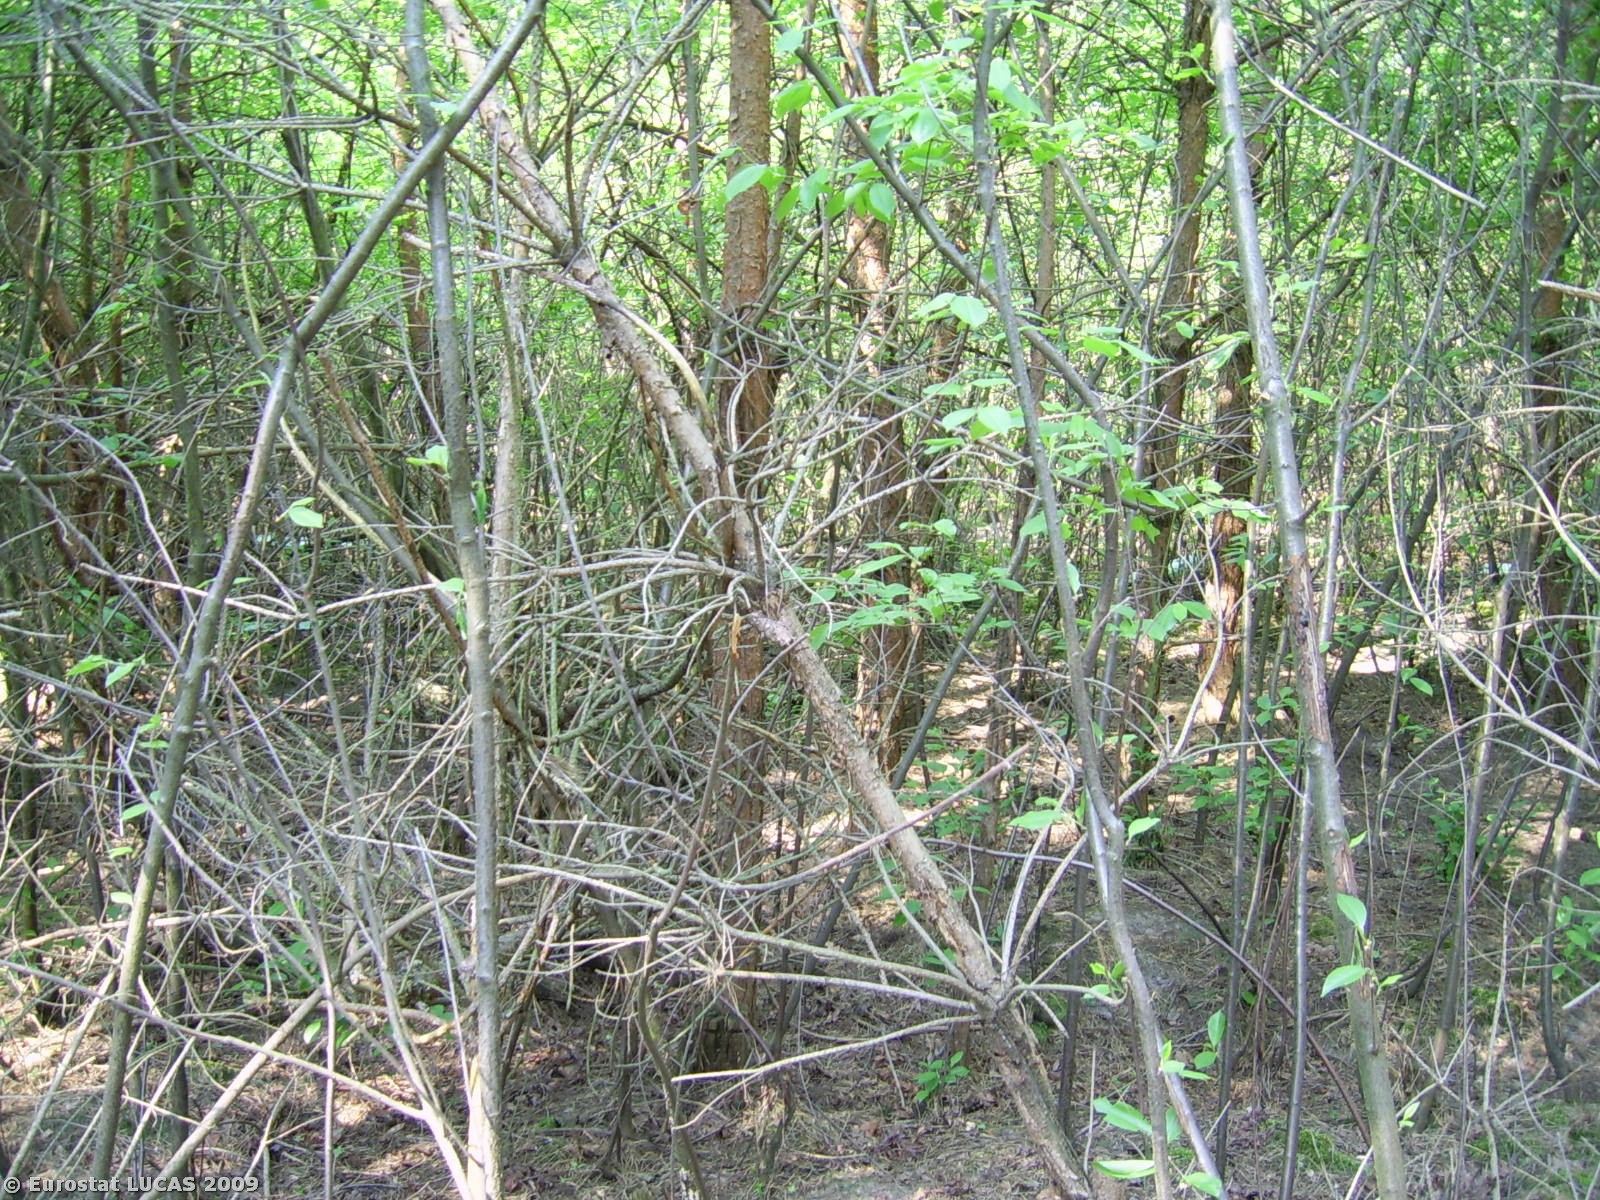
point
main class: Woodland
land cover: Mixed woodland
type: hemiboreal forest and nemoral coniferous forest and mixed broadleaved-coniferous forest
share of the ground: > 75 %
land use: Forestry
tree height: > 5 m
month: April
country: PL
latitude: 52.0500
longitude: 16.9068
